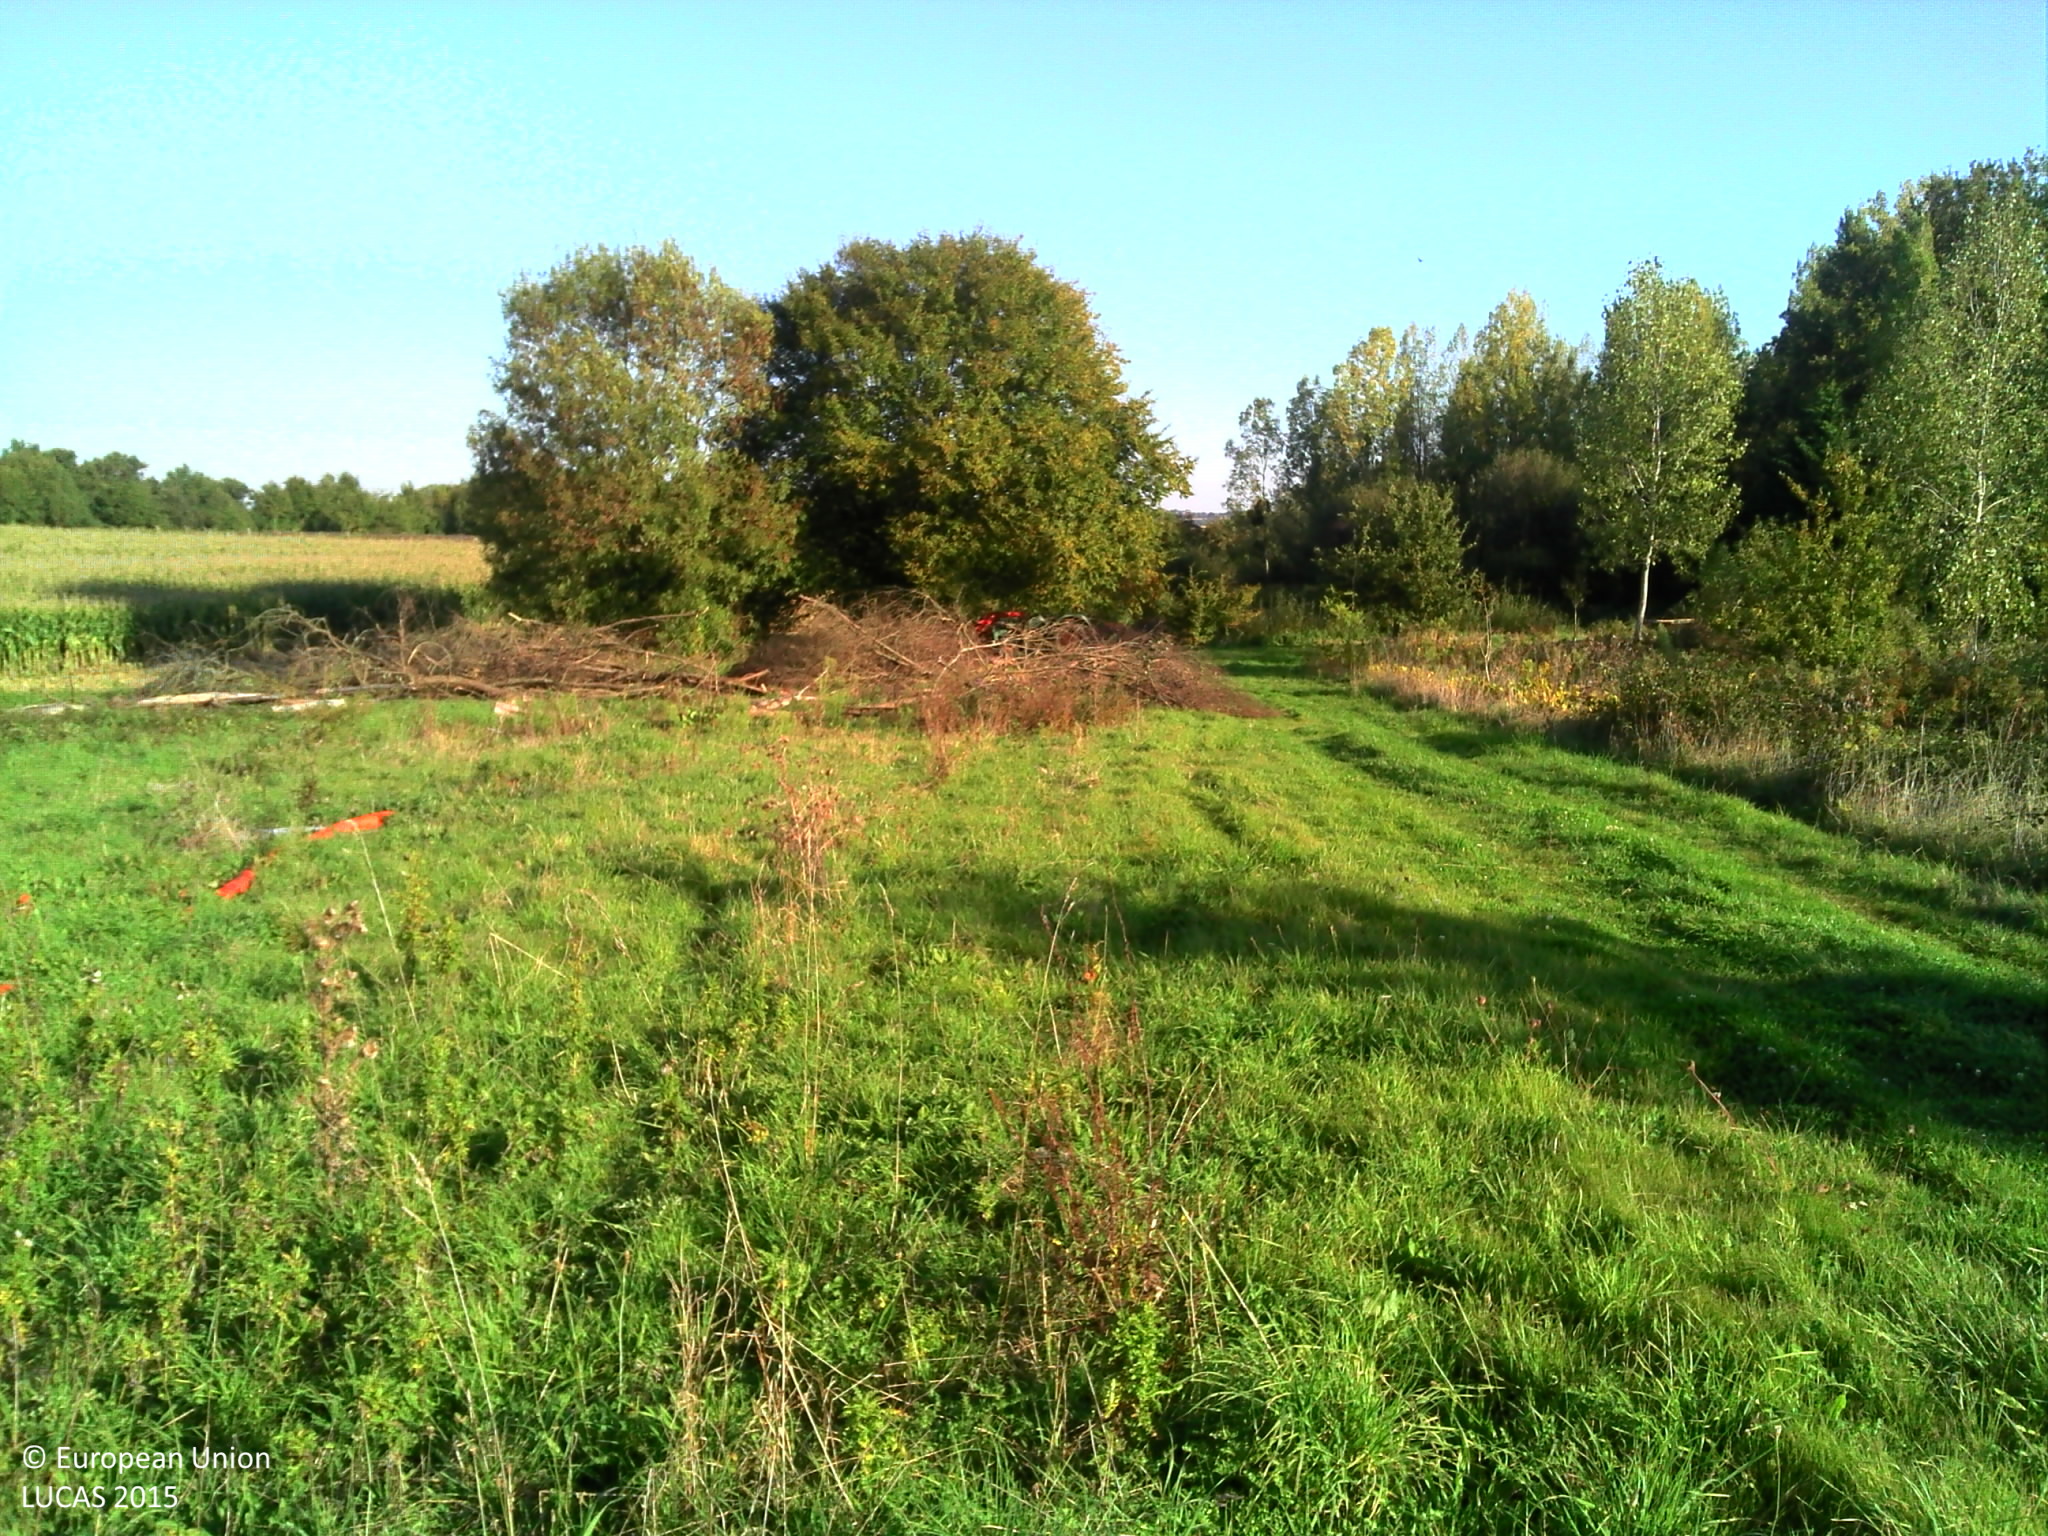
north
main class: Grassland
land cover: Grassland without tree/shrub cover
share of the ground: > 75 %
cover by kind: herbaceous plants 100 %
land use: Agriculture (excluding fallow land and kitchen gardens)
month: September
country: FR
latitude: 46.5932
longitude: -1.0625
